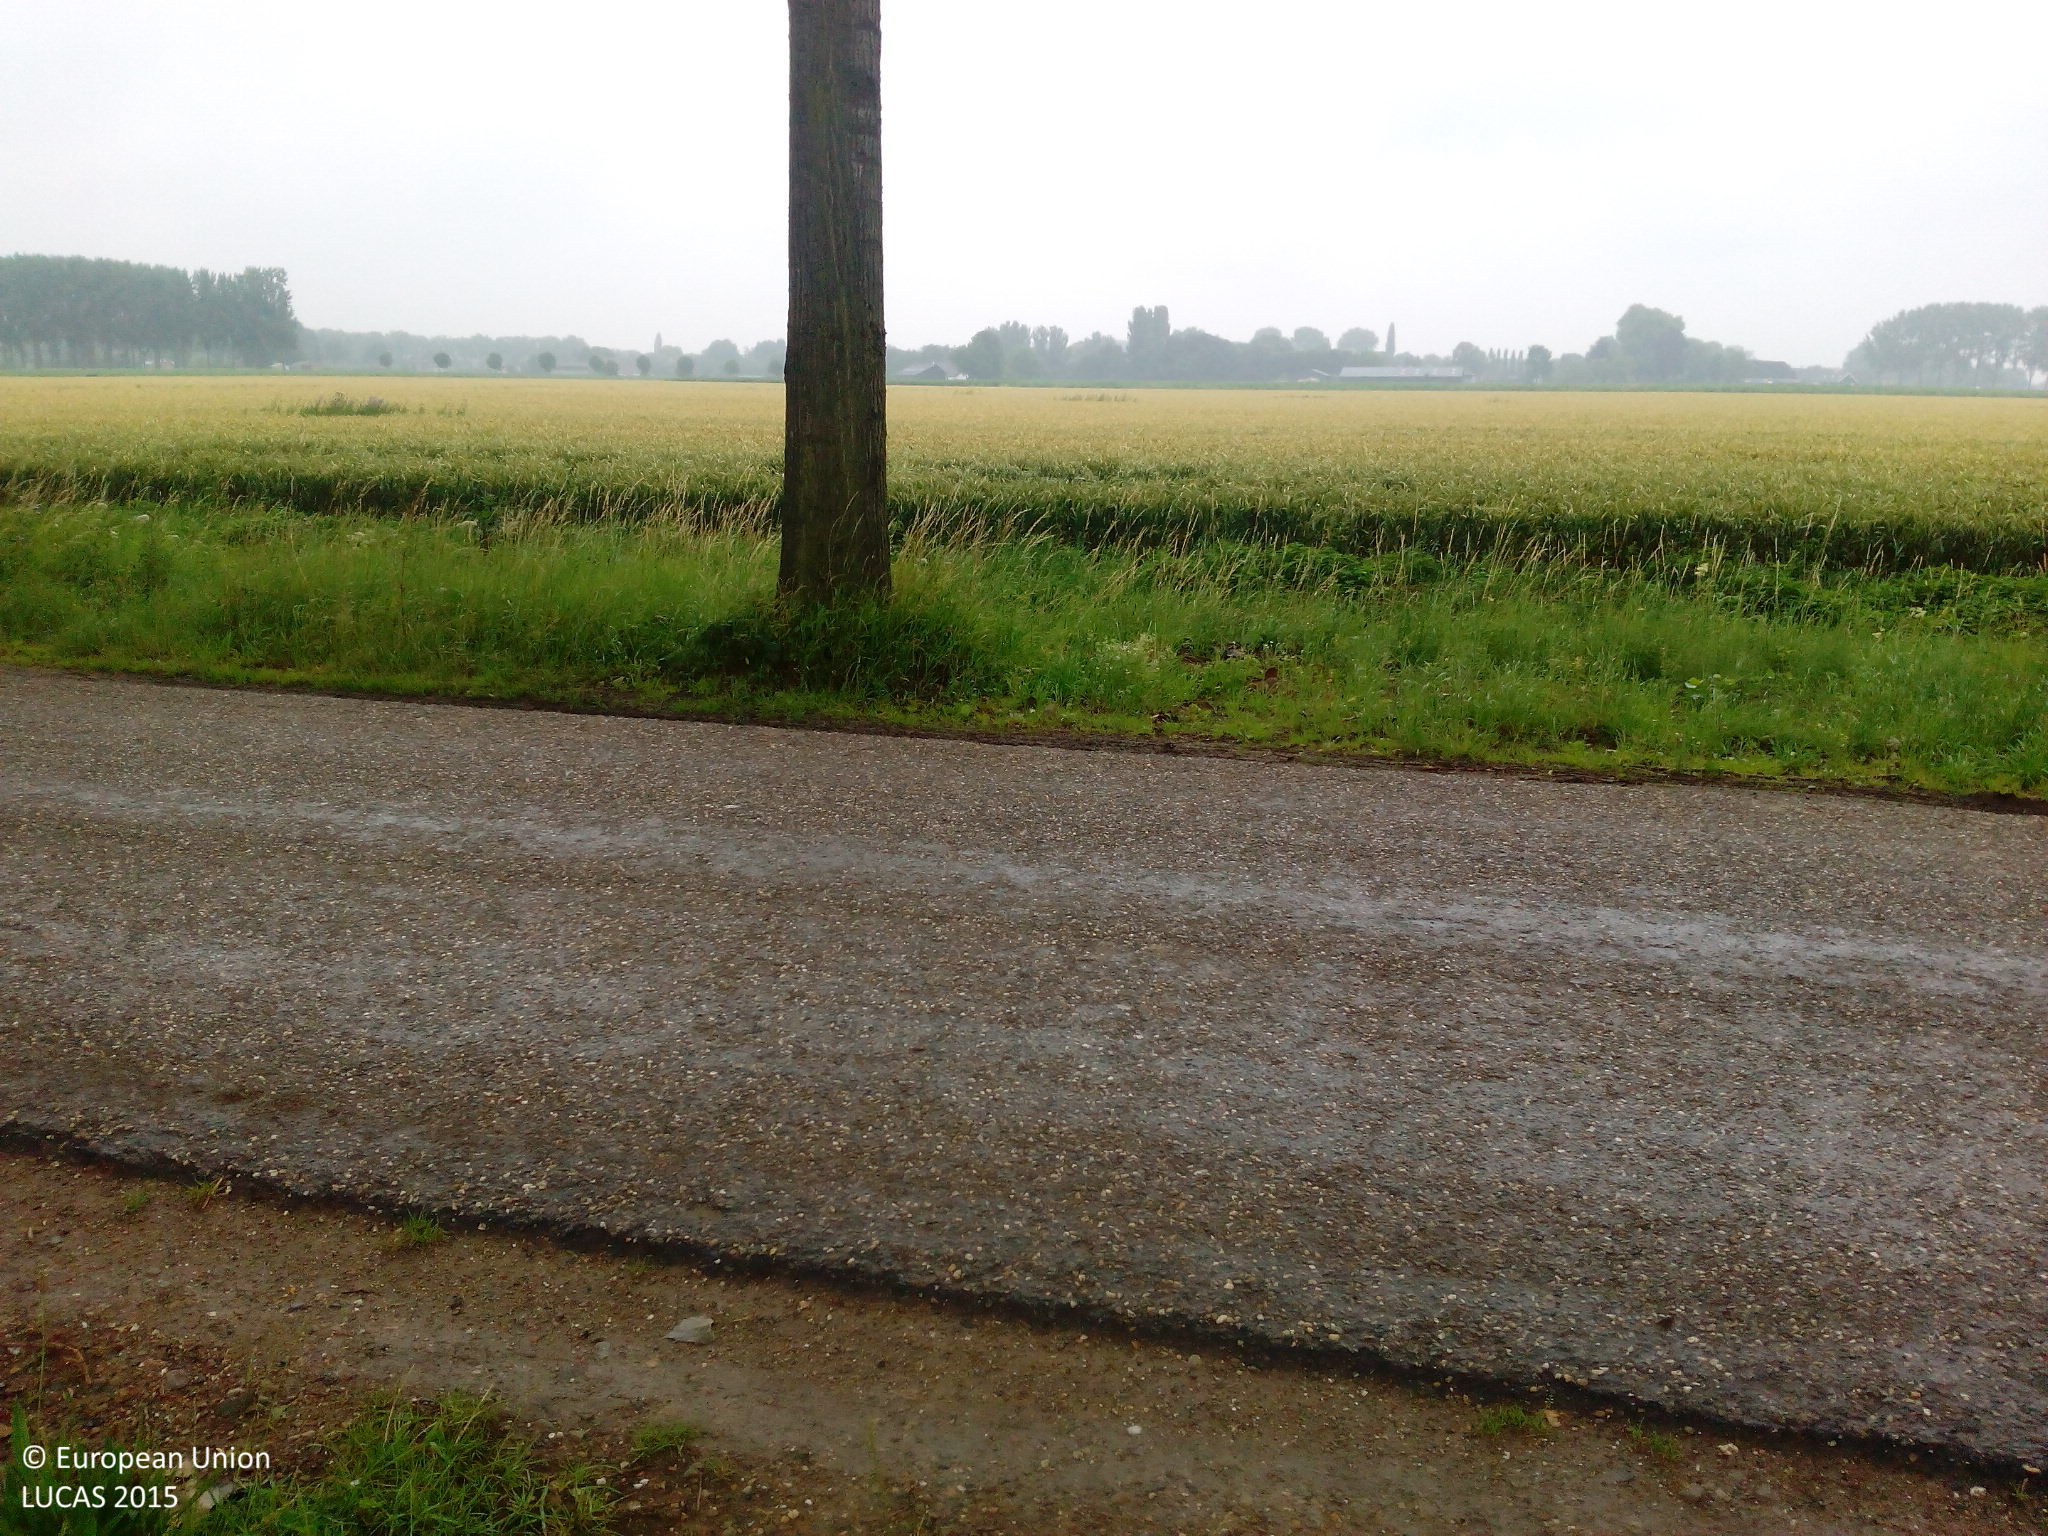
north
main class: Cropland
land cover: Common wheat
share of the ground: > 75 %
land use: Agriculture (excluding fallow land and kitchen gardens)
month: July
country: NL
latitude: 51.8681
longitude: 5.7143
